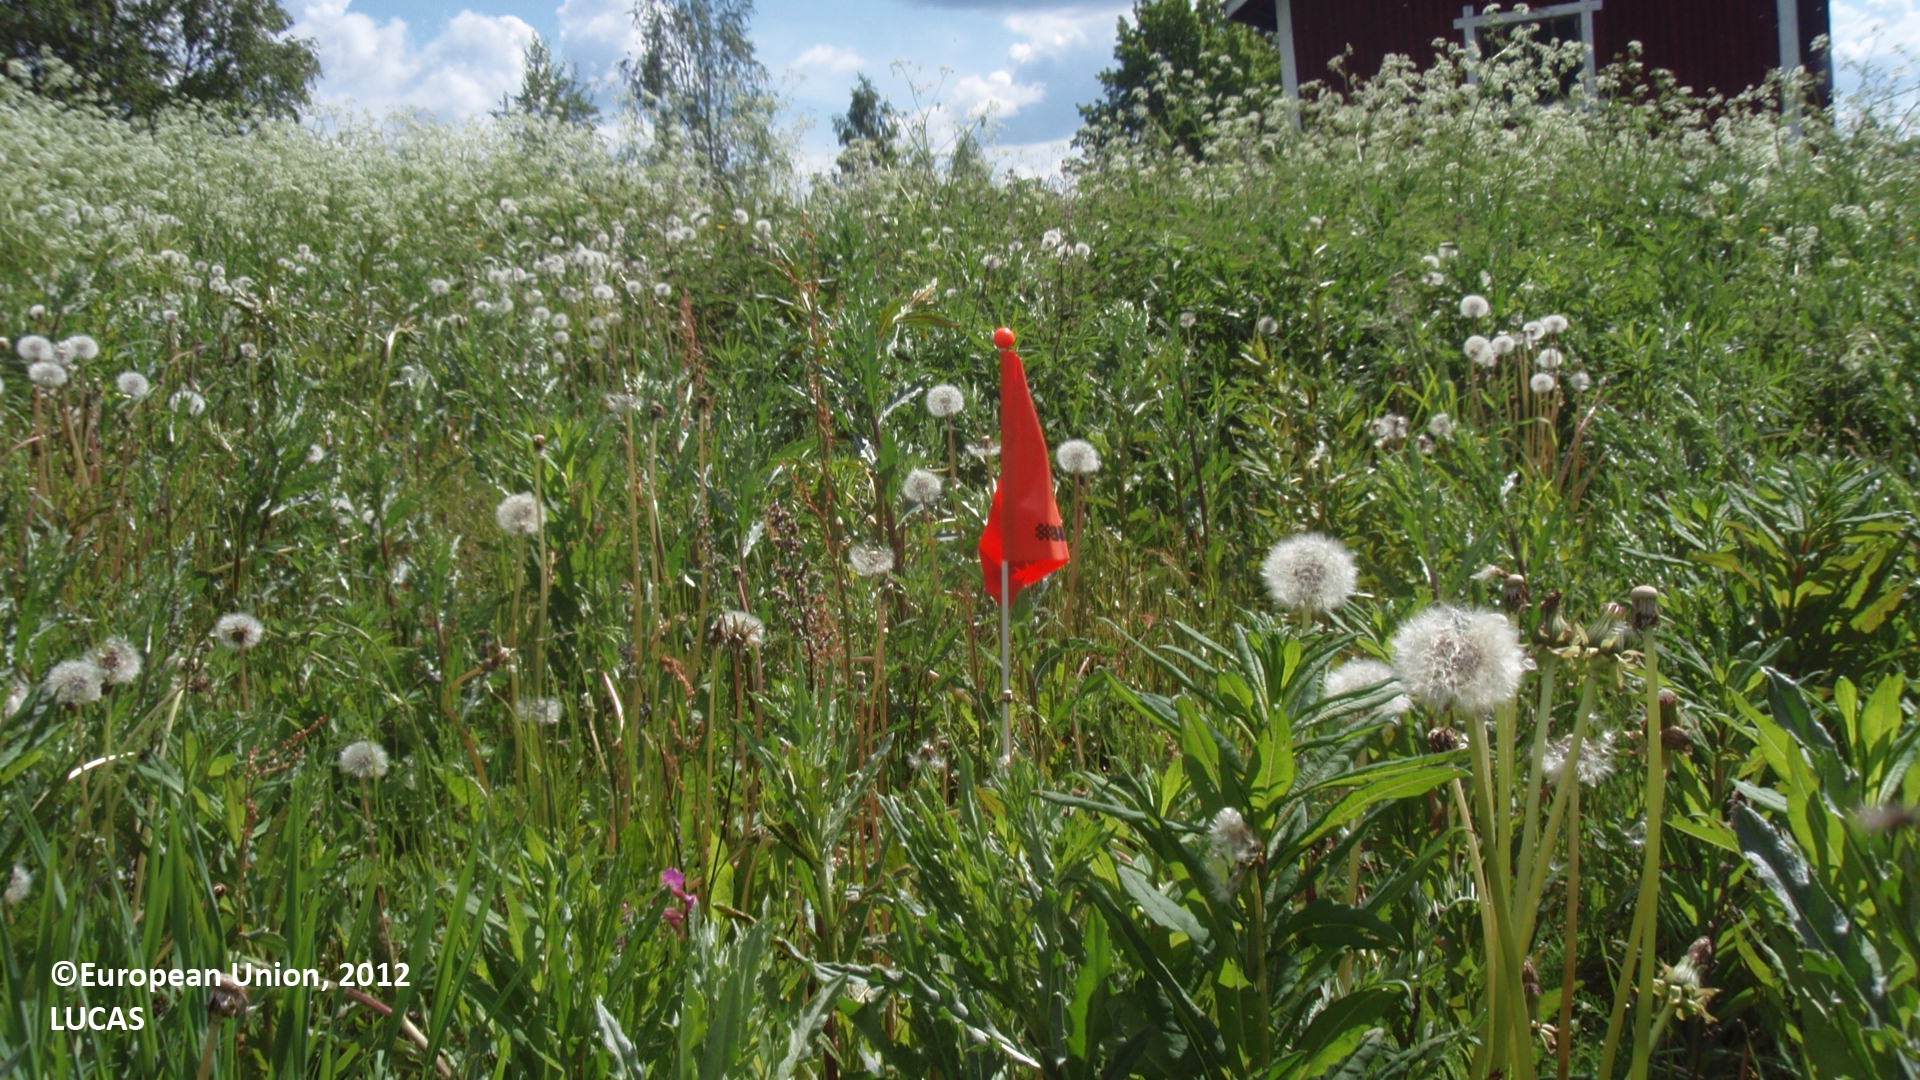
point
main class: Grassland
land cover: Spontaneously vegetated surfaces
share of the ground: > 75 %
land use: Fallow land
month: June
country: FI
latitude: 61.8178
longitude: 28.5258
